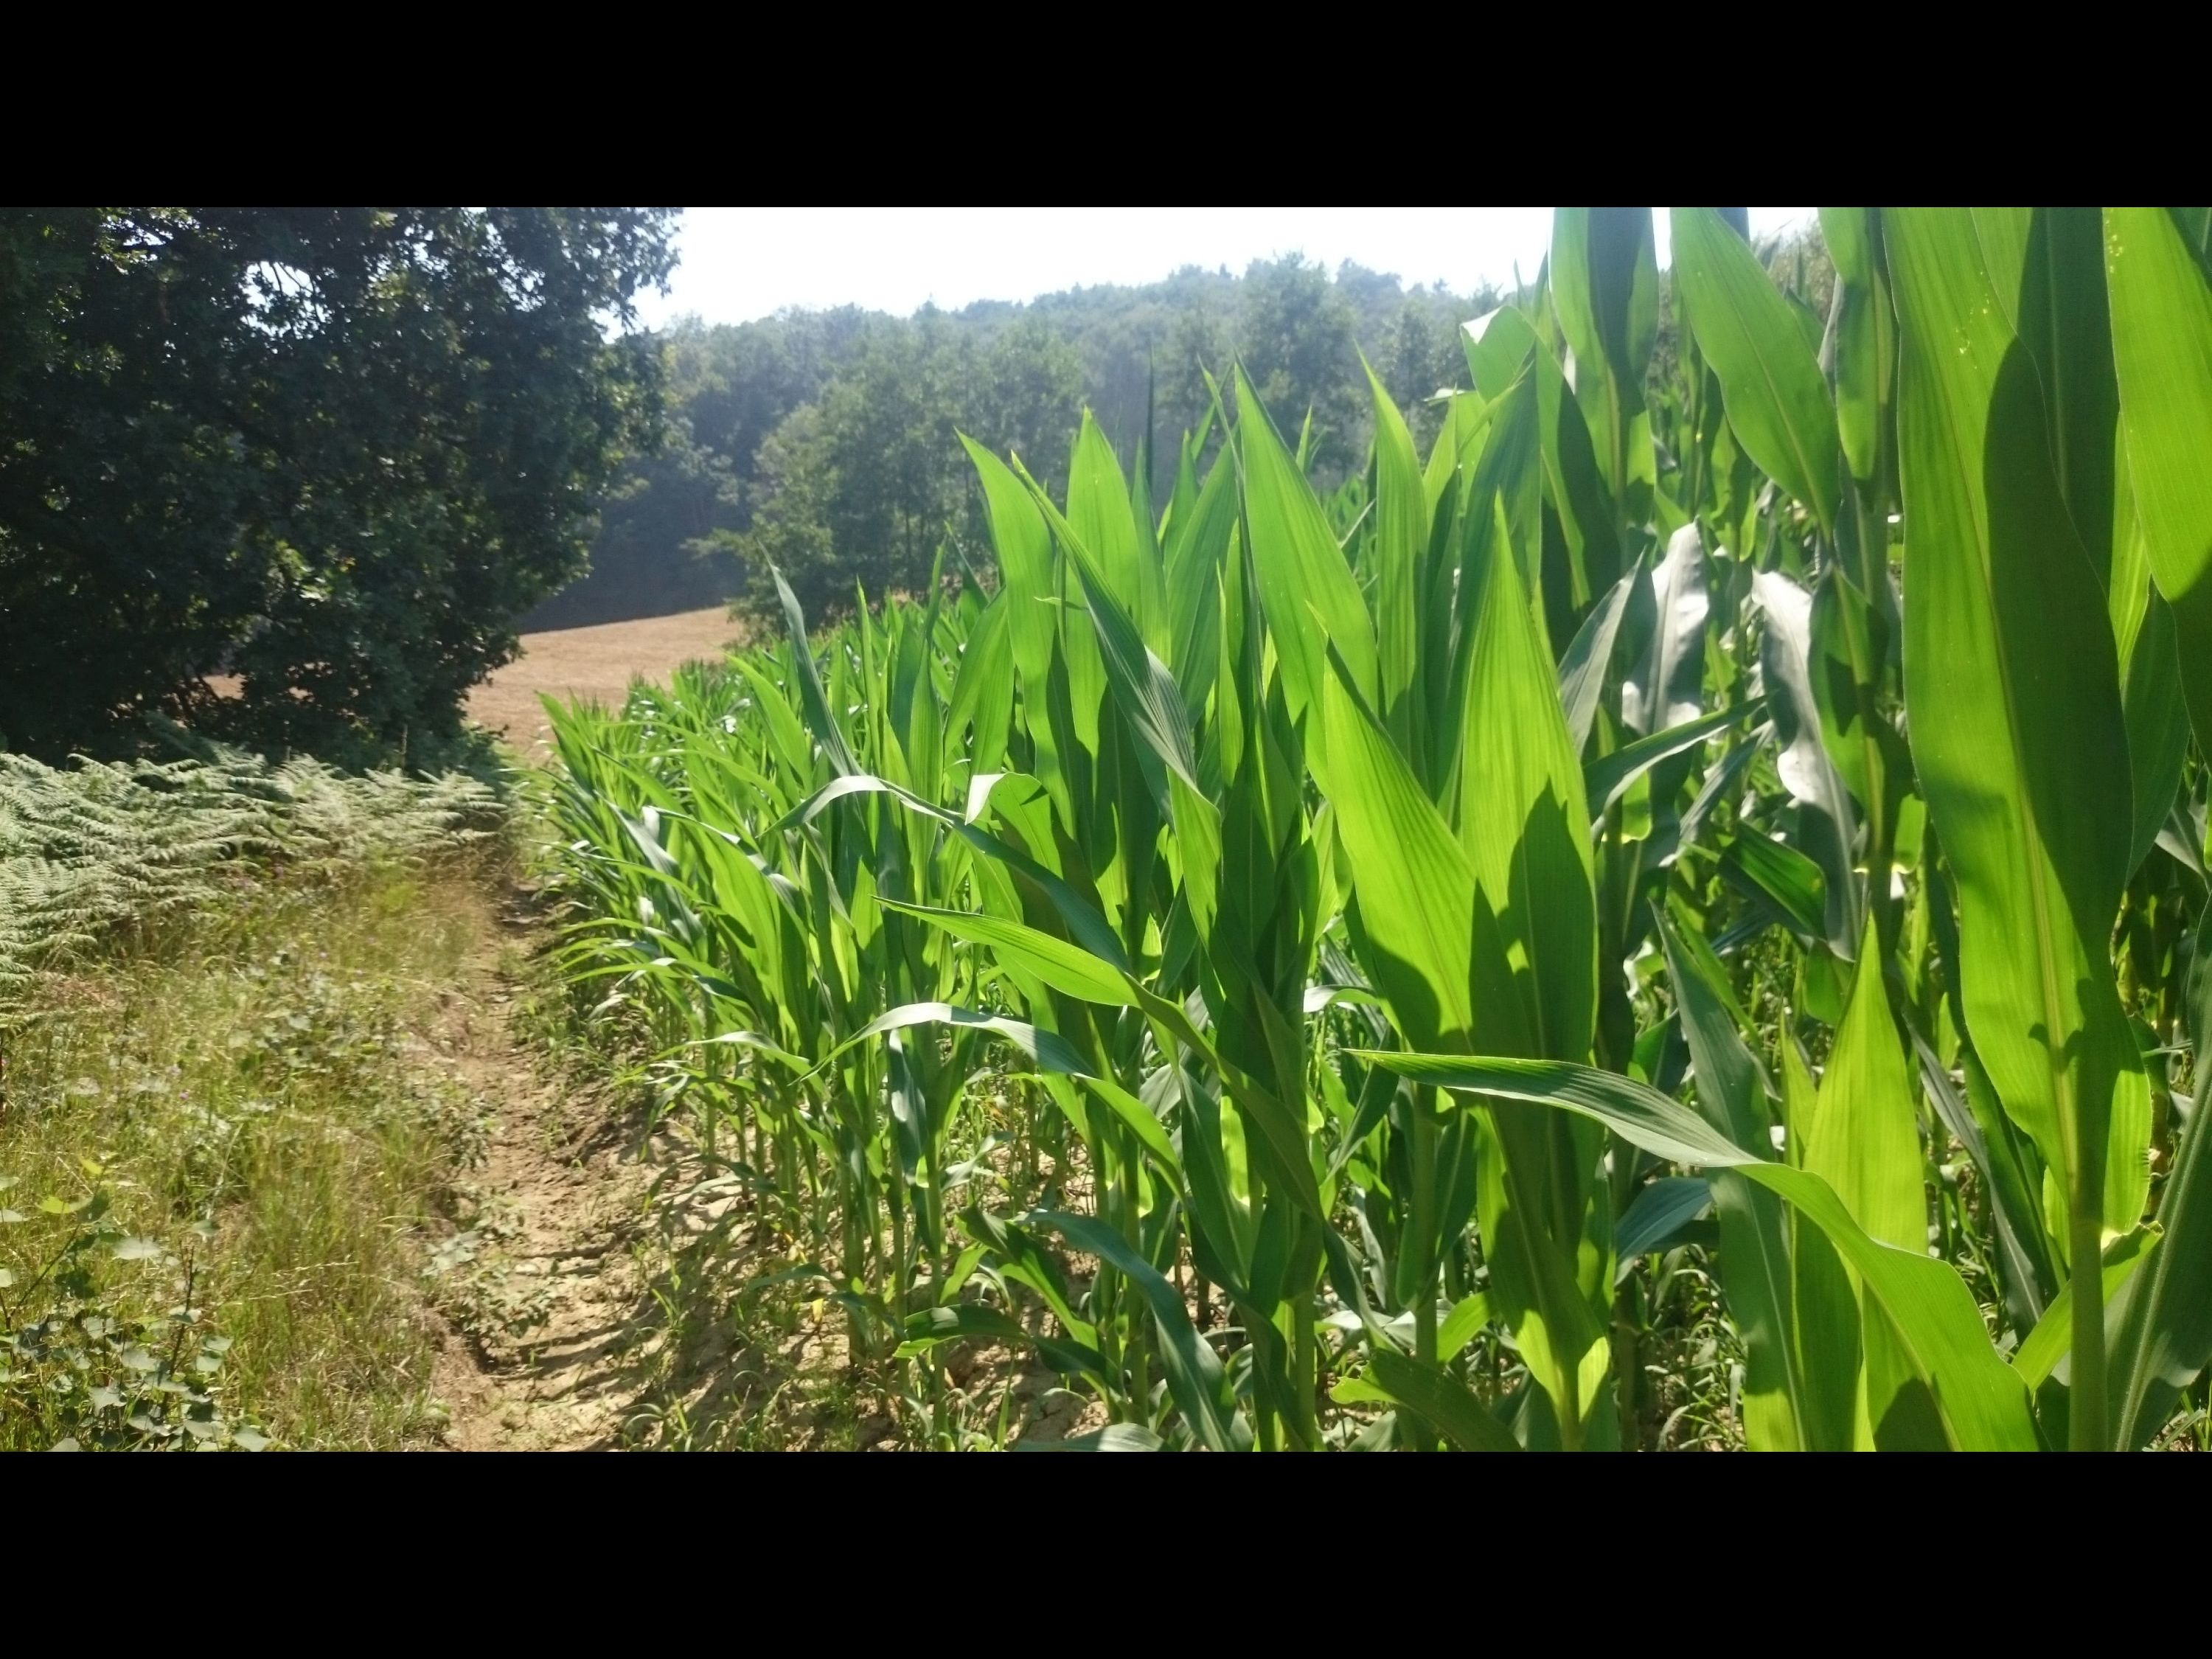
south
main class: Cropland
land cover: Maize
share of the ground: > 75 %
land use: Agriculture (excluding fallow land and kitchen gardens)
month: July
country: AT
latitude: 47.0127
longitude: 16.0126
